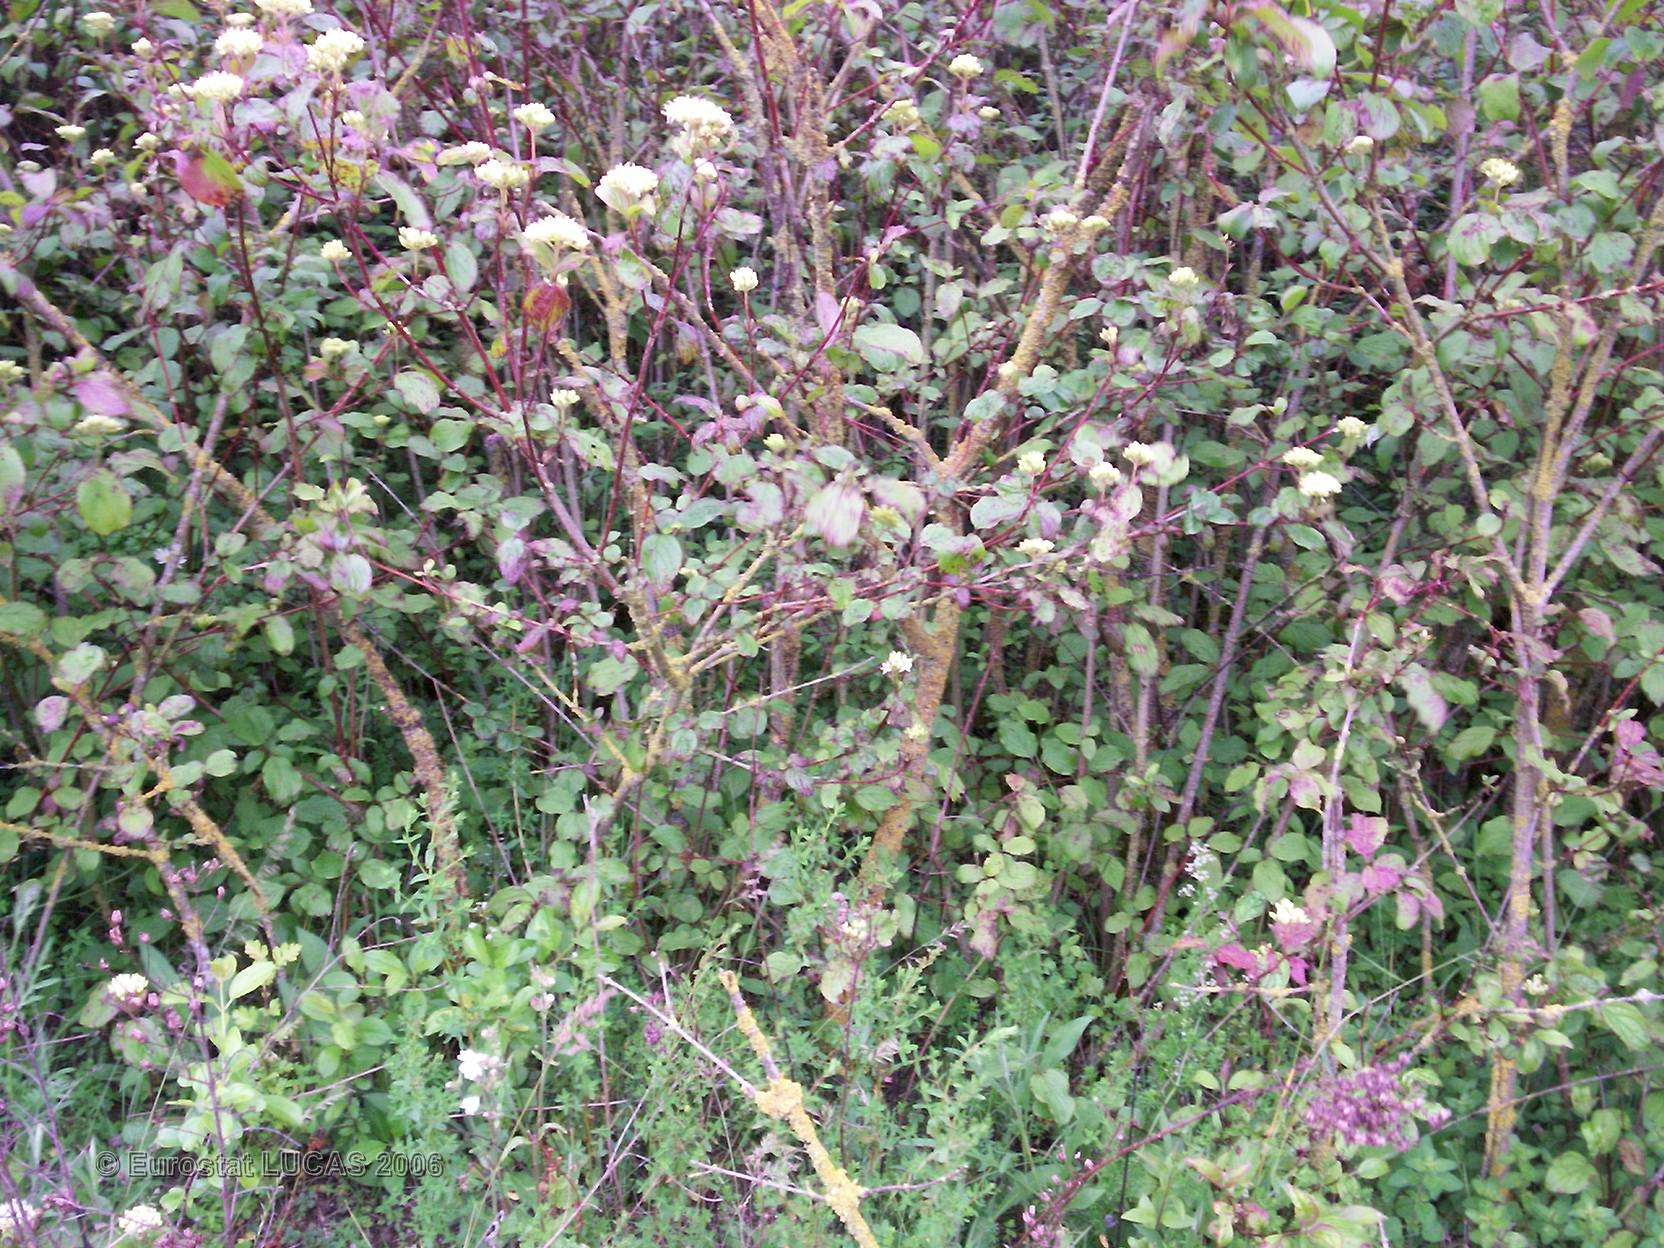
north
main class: Cropland
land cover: Barley
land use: Agriculture (excluding fallow land and kitchen gardens)
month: June
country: FR
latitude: 48.6785
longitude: 4.4420
